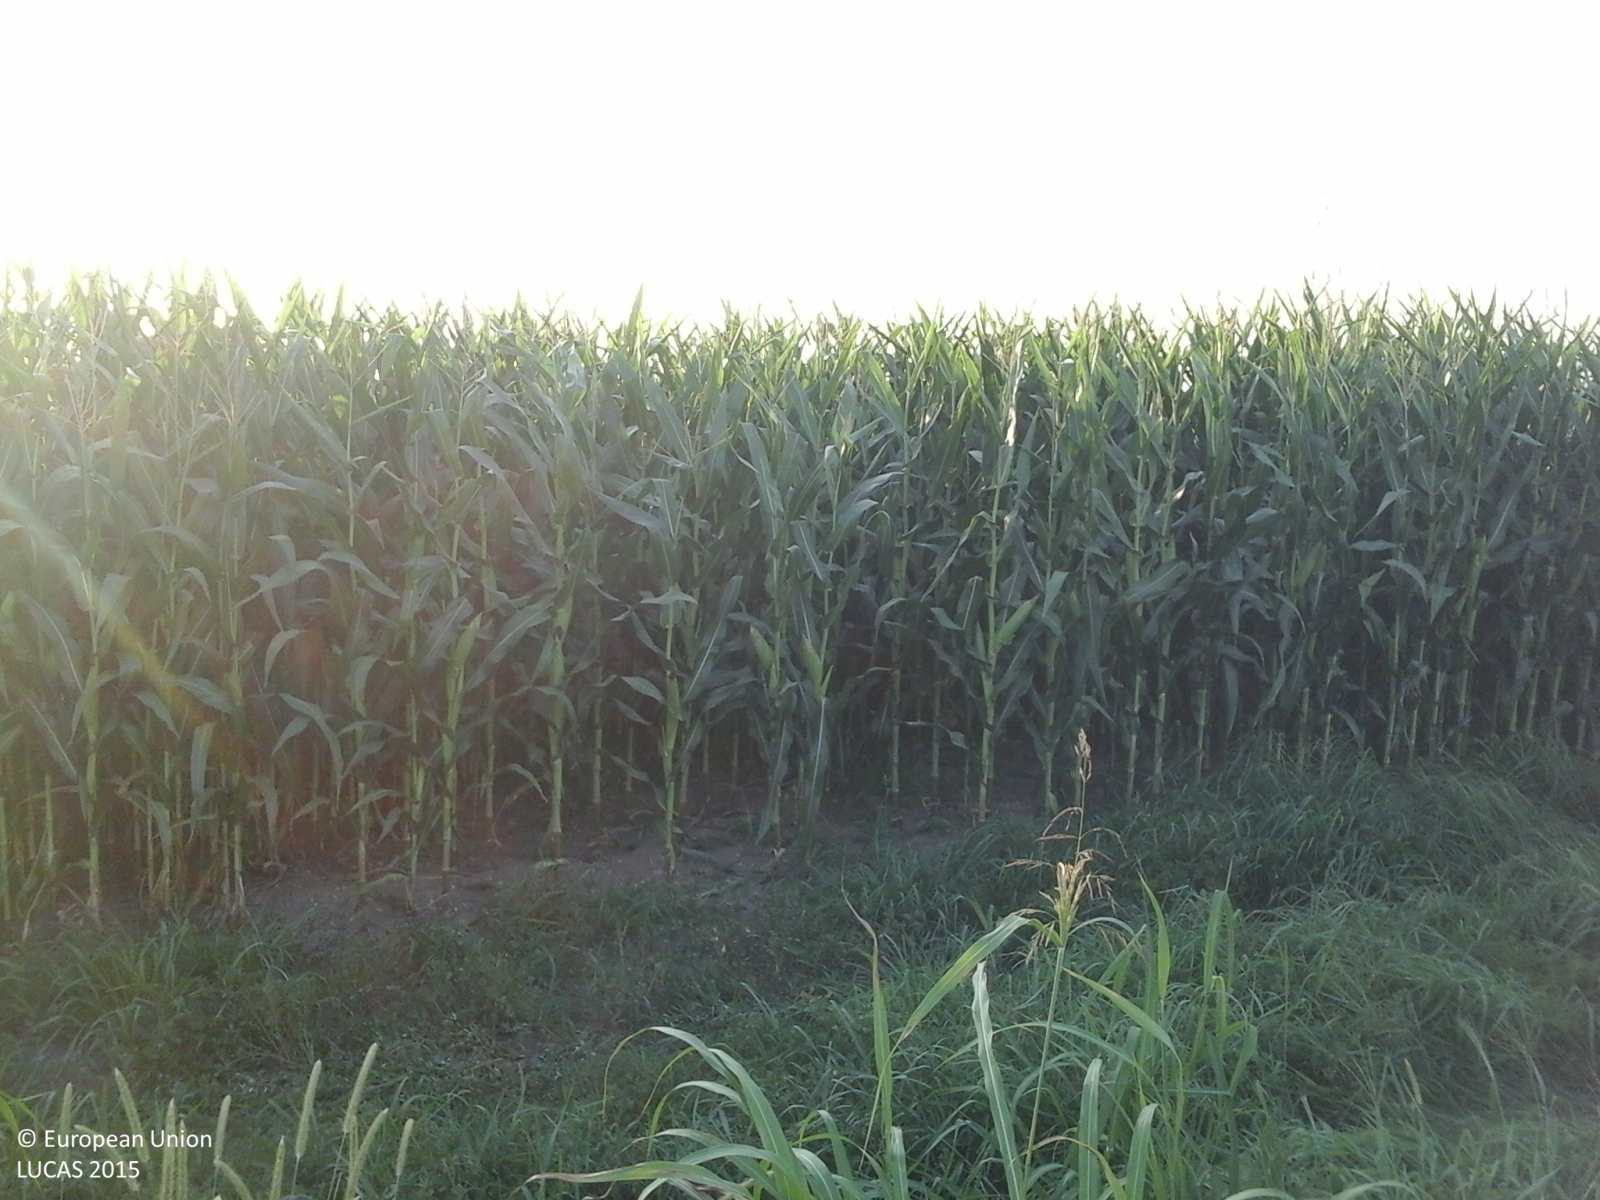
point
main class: Cropland
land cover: Maize
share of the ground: > 75 %
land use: Agriculture (excluding fallow land and kitchen gardens)
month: July
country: IT
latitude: 45.4448
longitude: 8.9151
